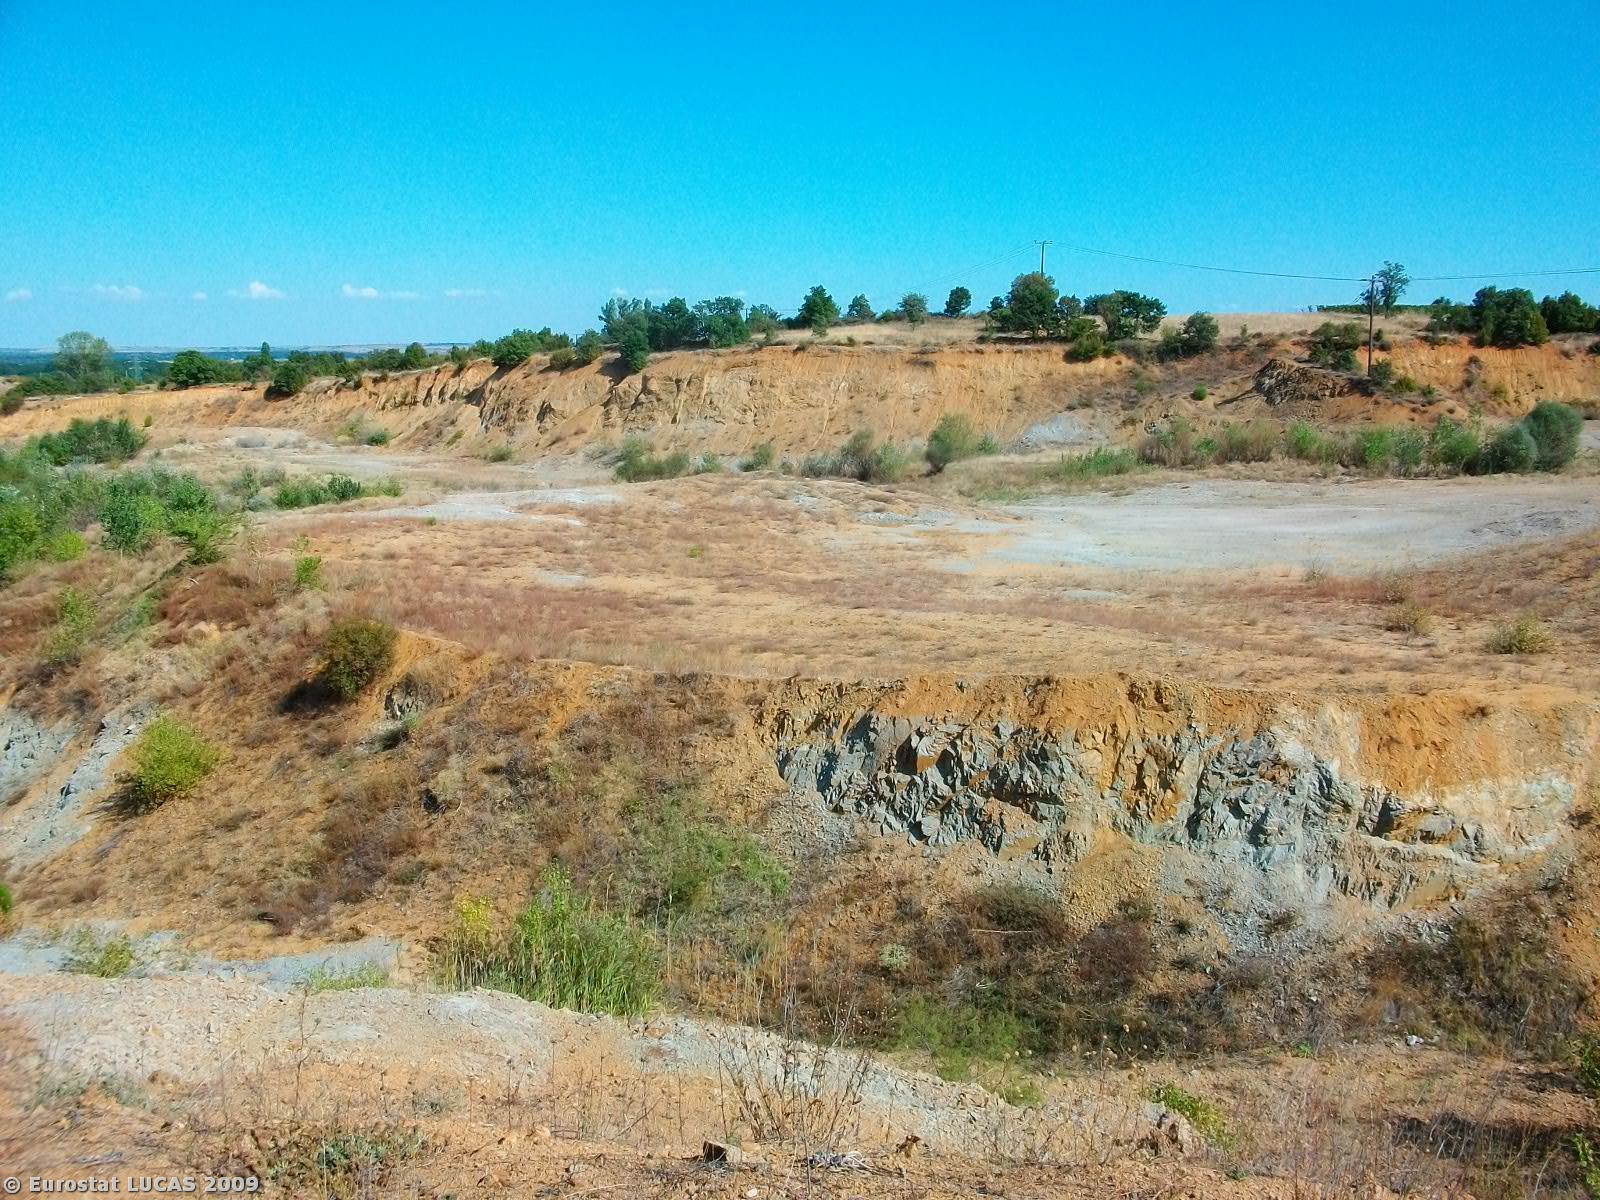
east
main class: Grassland
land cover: Grassland with sparse tree/shrub cover
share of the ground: 10 - 25 %
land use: Unused
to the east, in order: Grassland with sparse tree/shrub cover; Ponds and wetlands; Bare land; Grassland with sparse tree/shrub cover; Bare land; Broadleaved woodland; Grassland with sparse tree/shrub cover
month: August
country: GR
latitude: 41.3298
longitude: 26.4808
